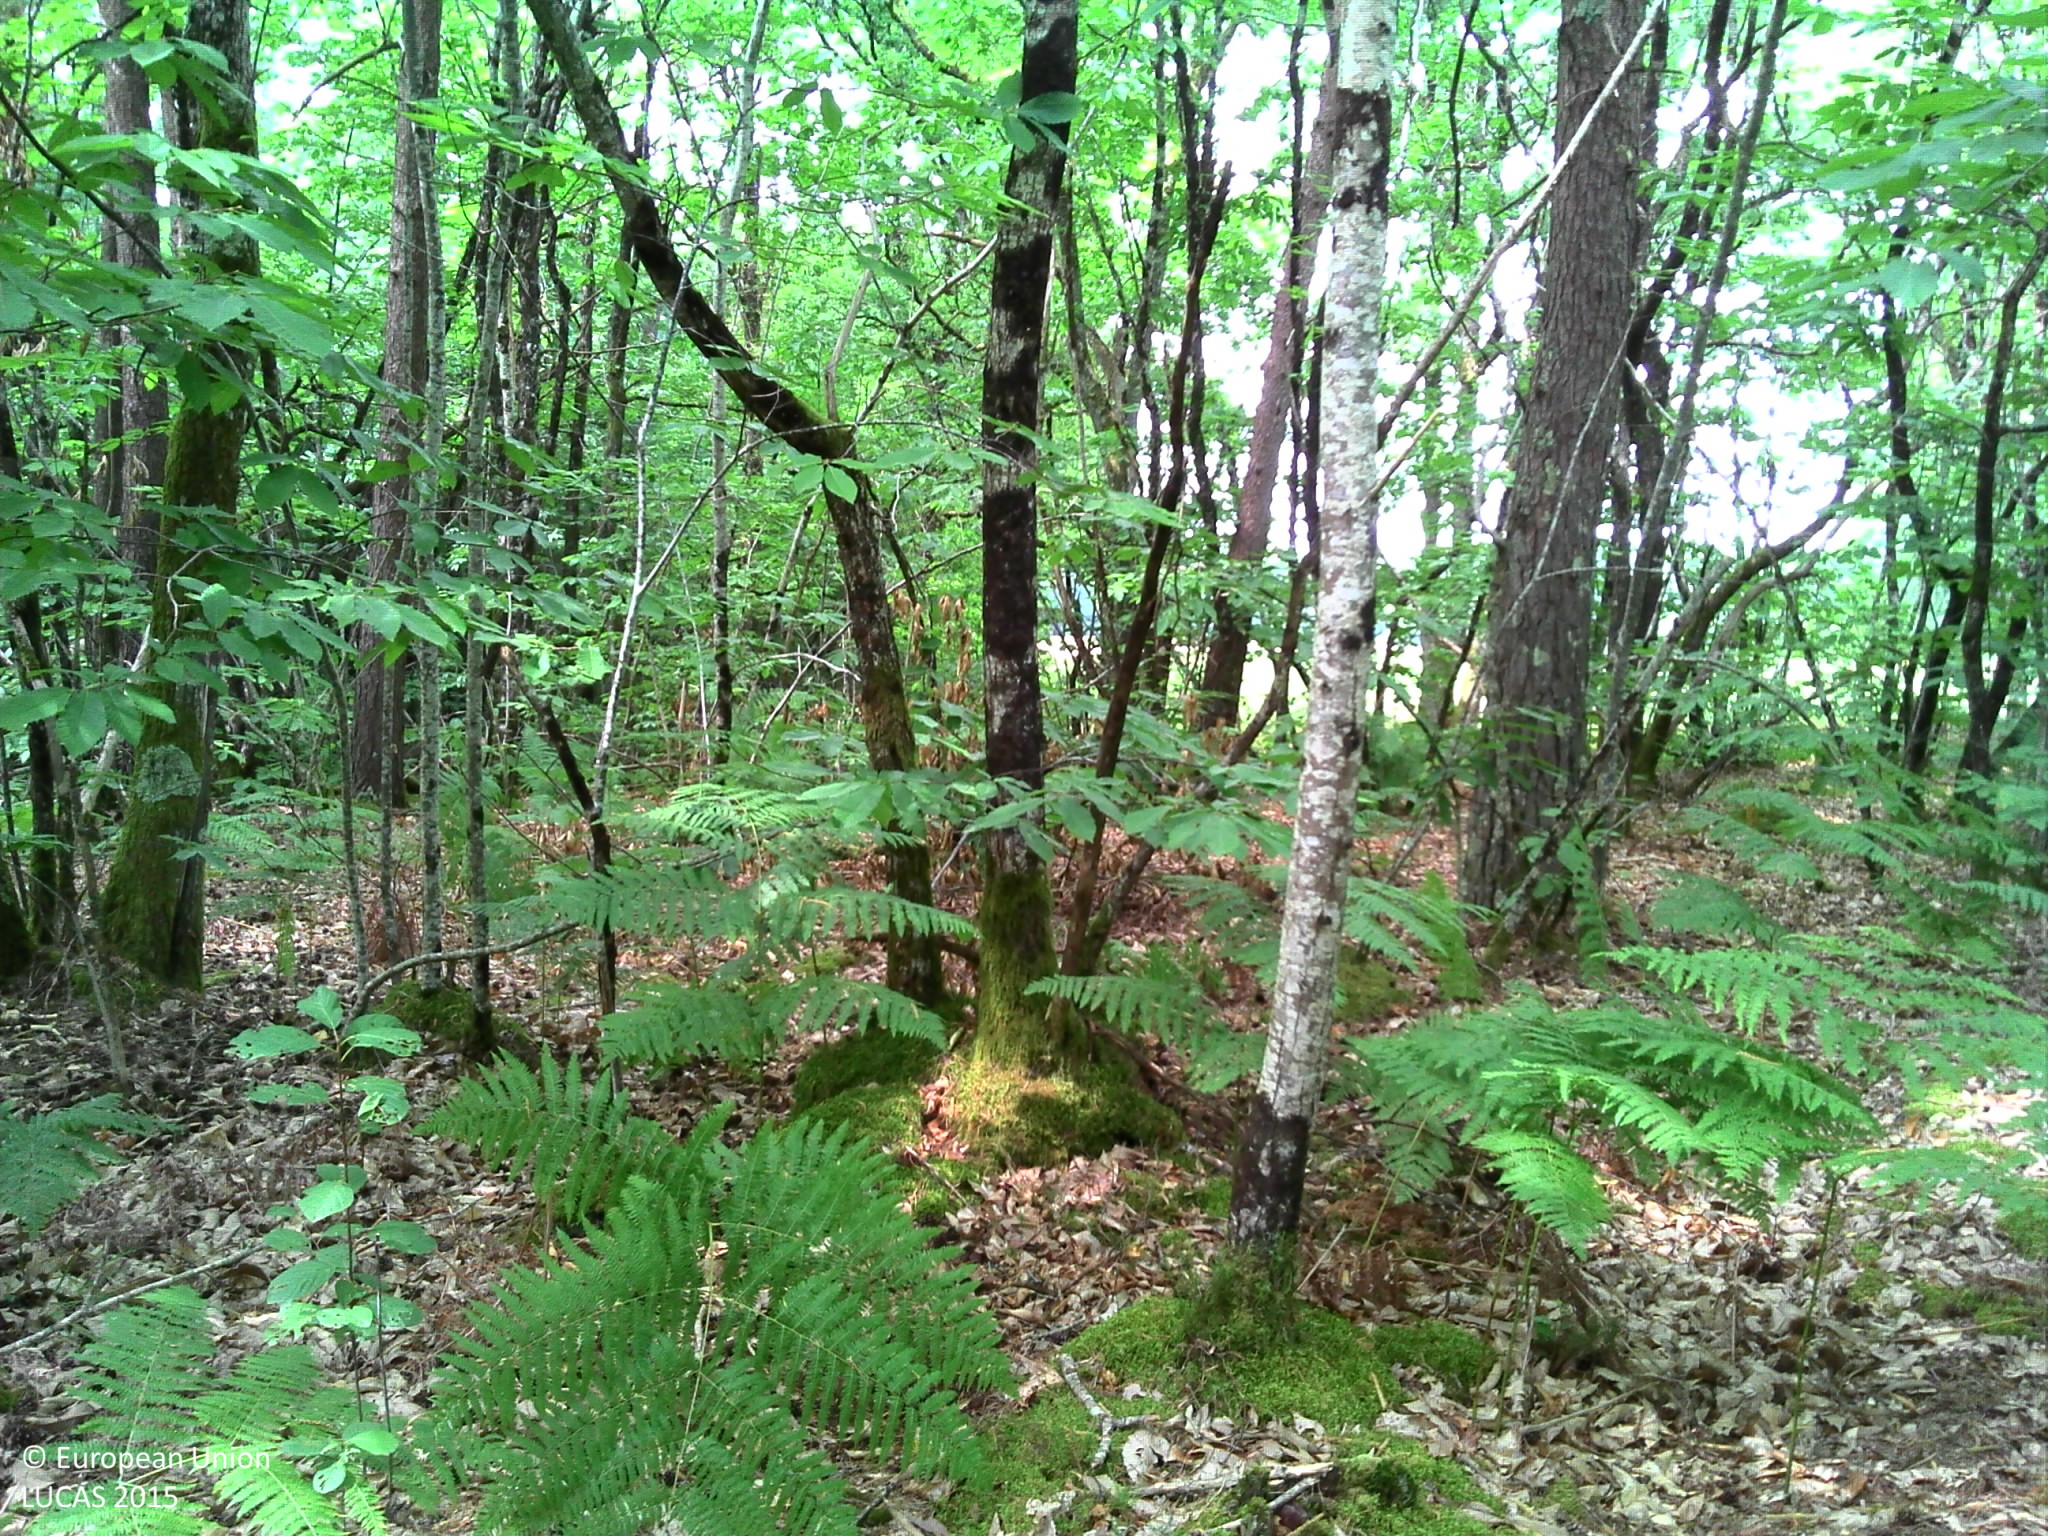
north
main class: Woodland
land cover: Spruce dominated mixed woodland
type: hemiboreal forest and nemoral coniferous forest and mixed broadleaved-coniferous forest
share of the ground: > 75 %
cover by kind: broadleaved forest trees 45 %, lichens and mosses 25 %, coniferous forest trees 15 %, herbaceous plants 15 %
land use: Forestry
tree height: > 5 m
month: July
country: FR
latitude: 45.7051
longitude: 0.6493
